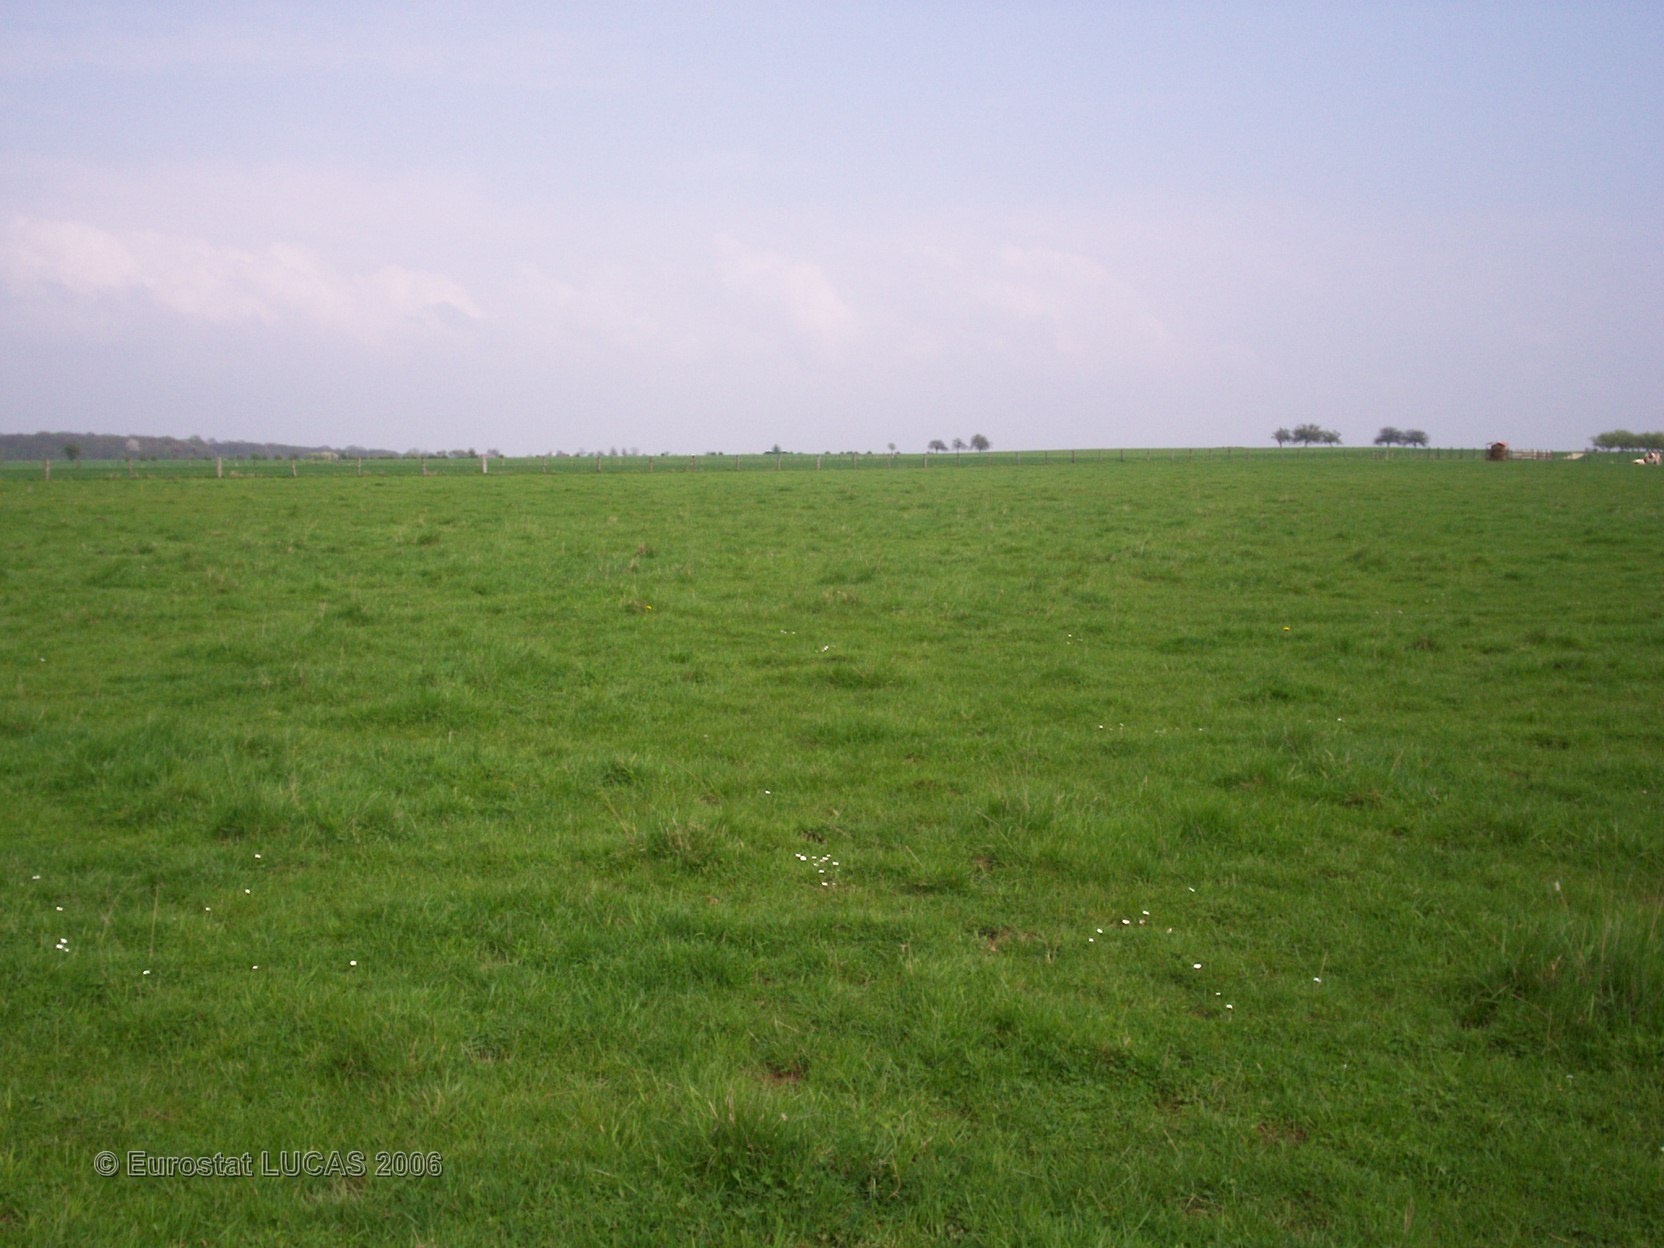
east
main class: Grassland
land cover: Grassland without tree/shrub cover
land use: Agriculture (excluding fallow land and kitchen gardens)
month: April
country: FR
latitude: 48.3290
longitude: 5.9401
